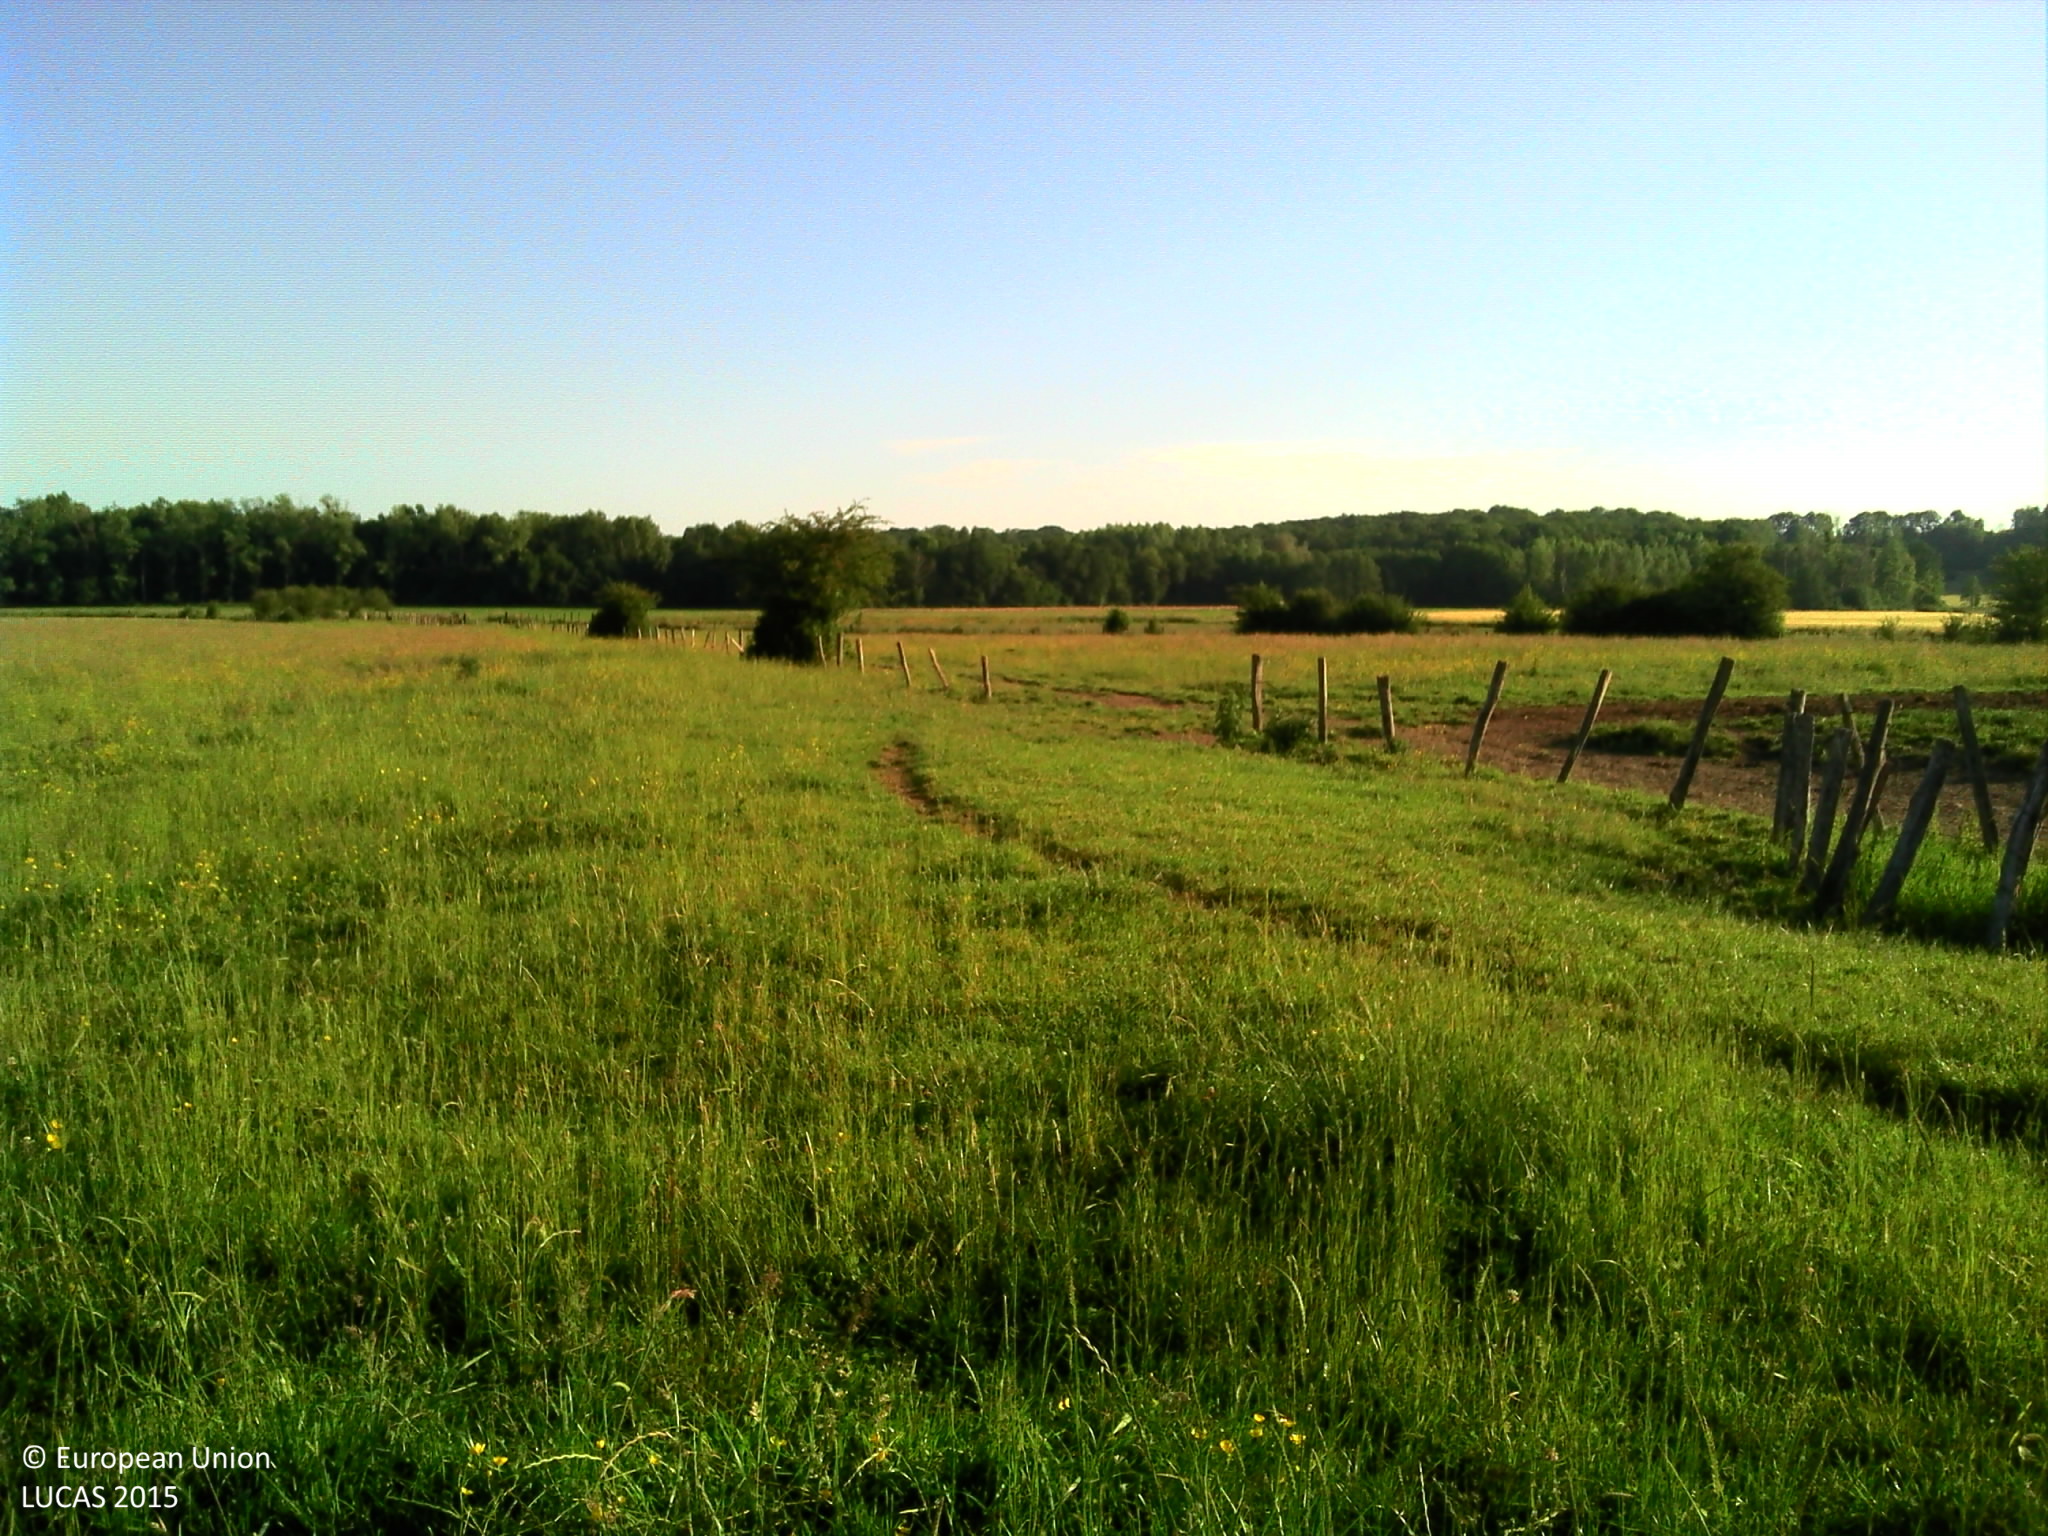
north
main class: Grassland
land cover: Grassland without tree/shrub cover
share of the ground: > 75 %
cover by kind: herbaceous plants 100 %
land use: Agriculture (excluding fallow land and kitchen gardens)
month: June
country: FR
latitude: 48.5149
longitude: 4.7859
